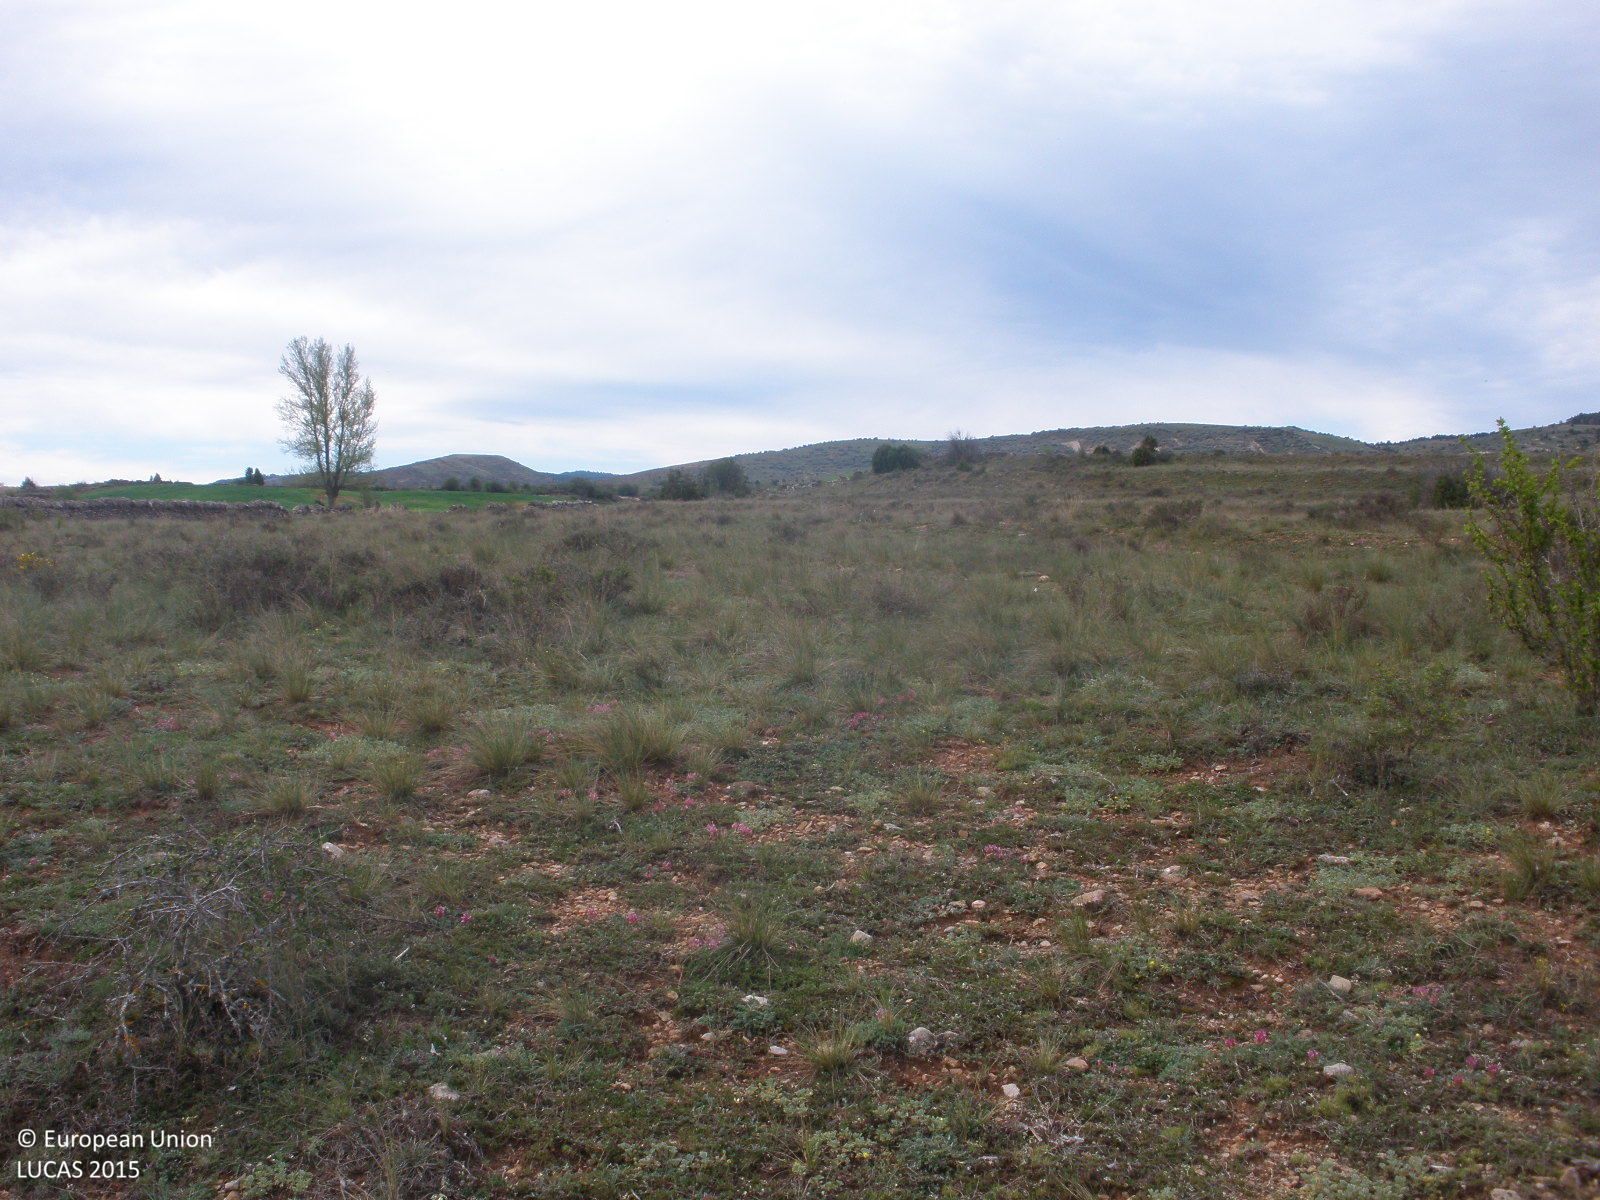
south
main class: Shrubland
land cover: Shrubland without tree cover
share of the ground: > 75 %
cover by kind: herbaceous plants 60 %, shrubs 30 %, consolidated bare surface 10 %
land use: Semi-natural and natural areas not in use
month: May
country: ES
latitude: 40.5124
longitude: -0.7616
